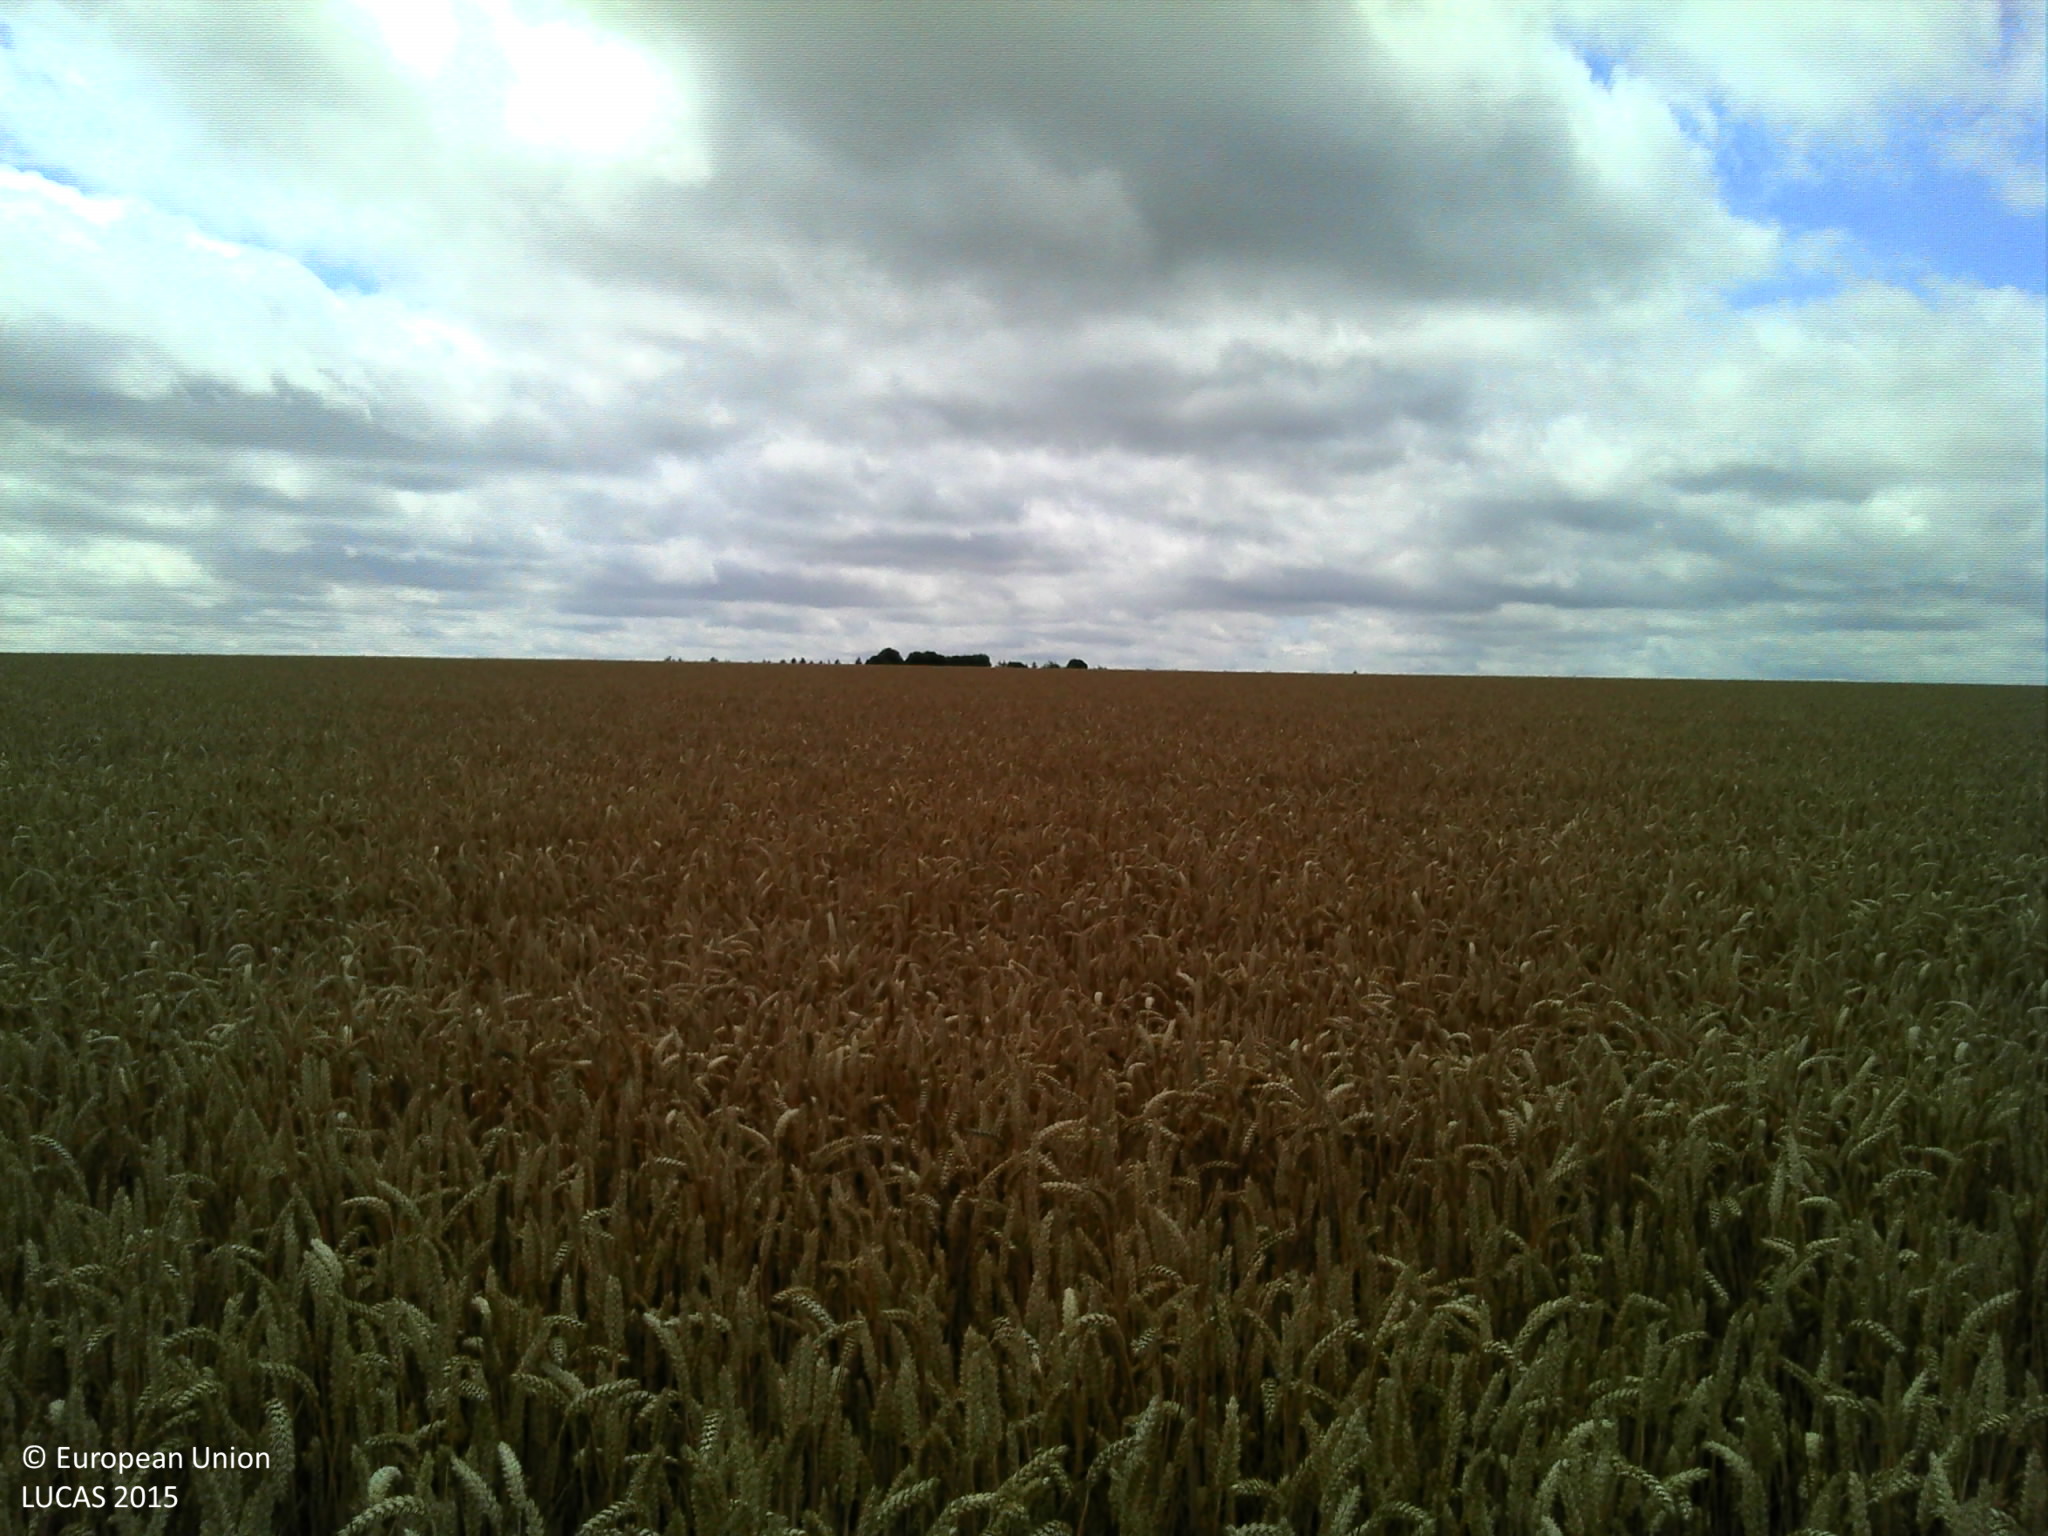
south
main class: Cropland
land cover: Common wheat
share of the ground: > 75 %
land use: Agriculture (excluding fallow land and kitchen gardens)
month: July
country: FR
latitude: 48.9762
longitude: -0.2665
